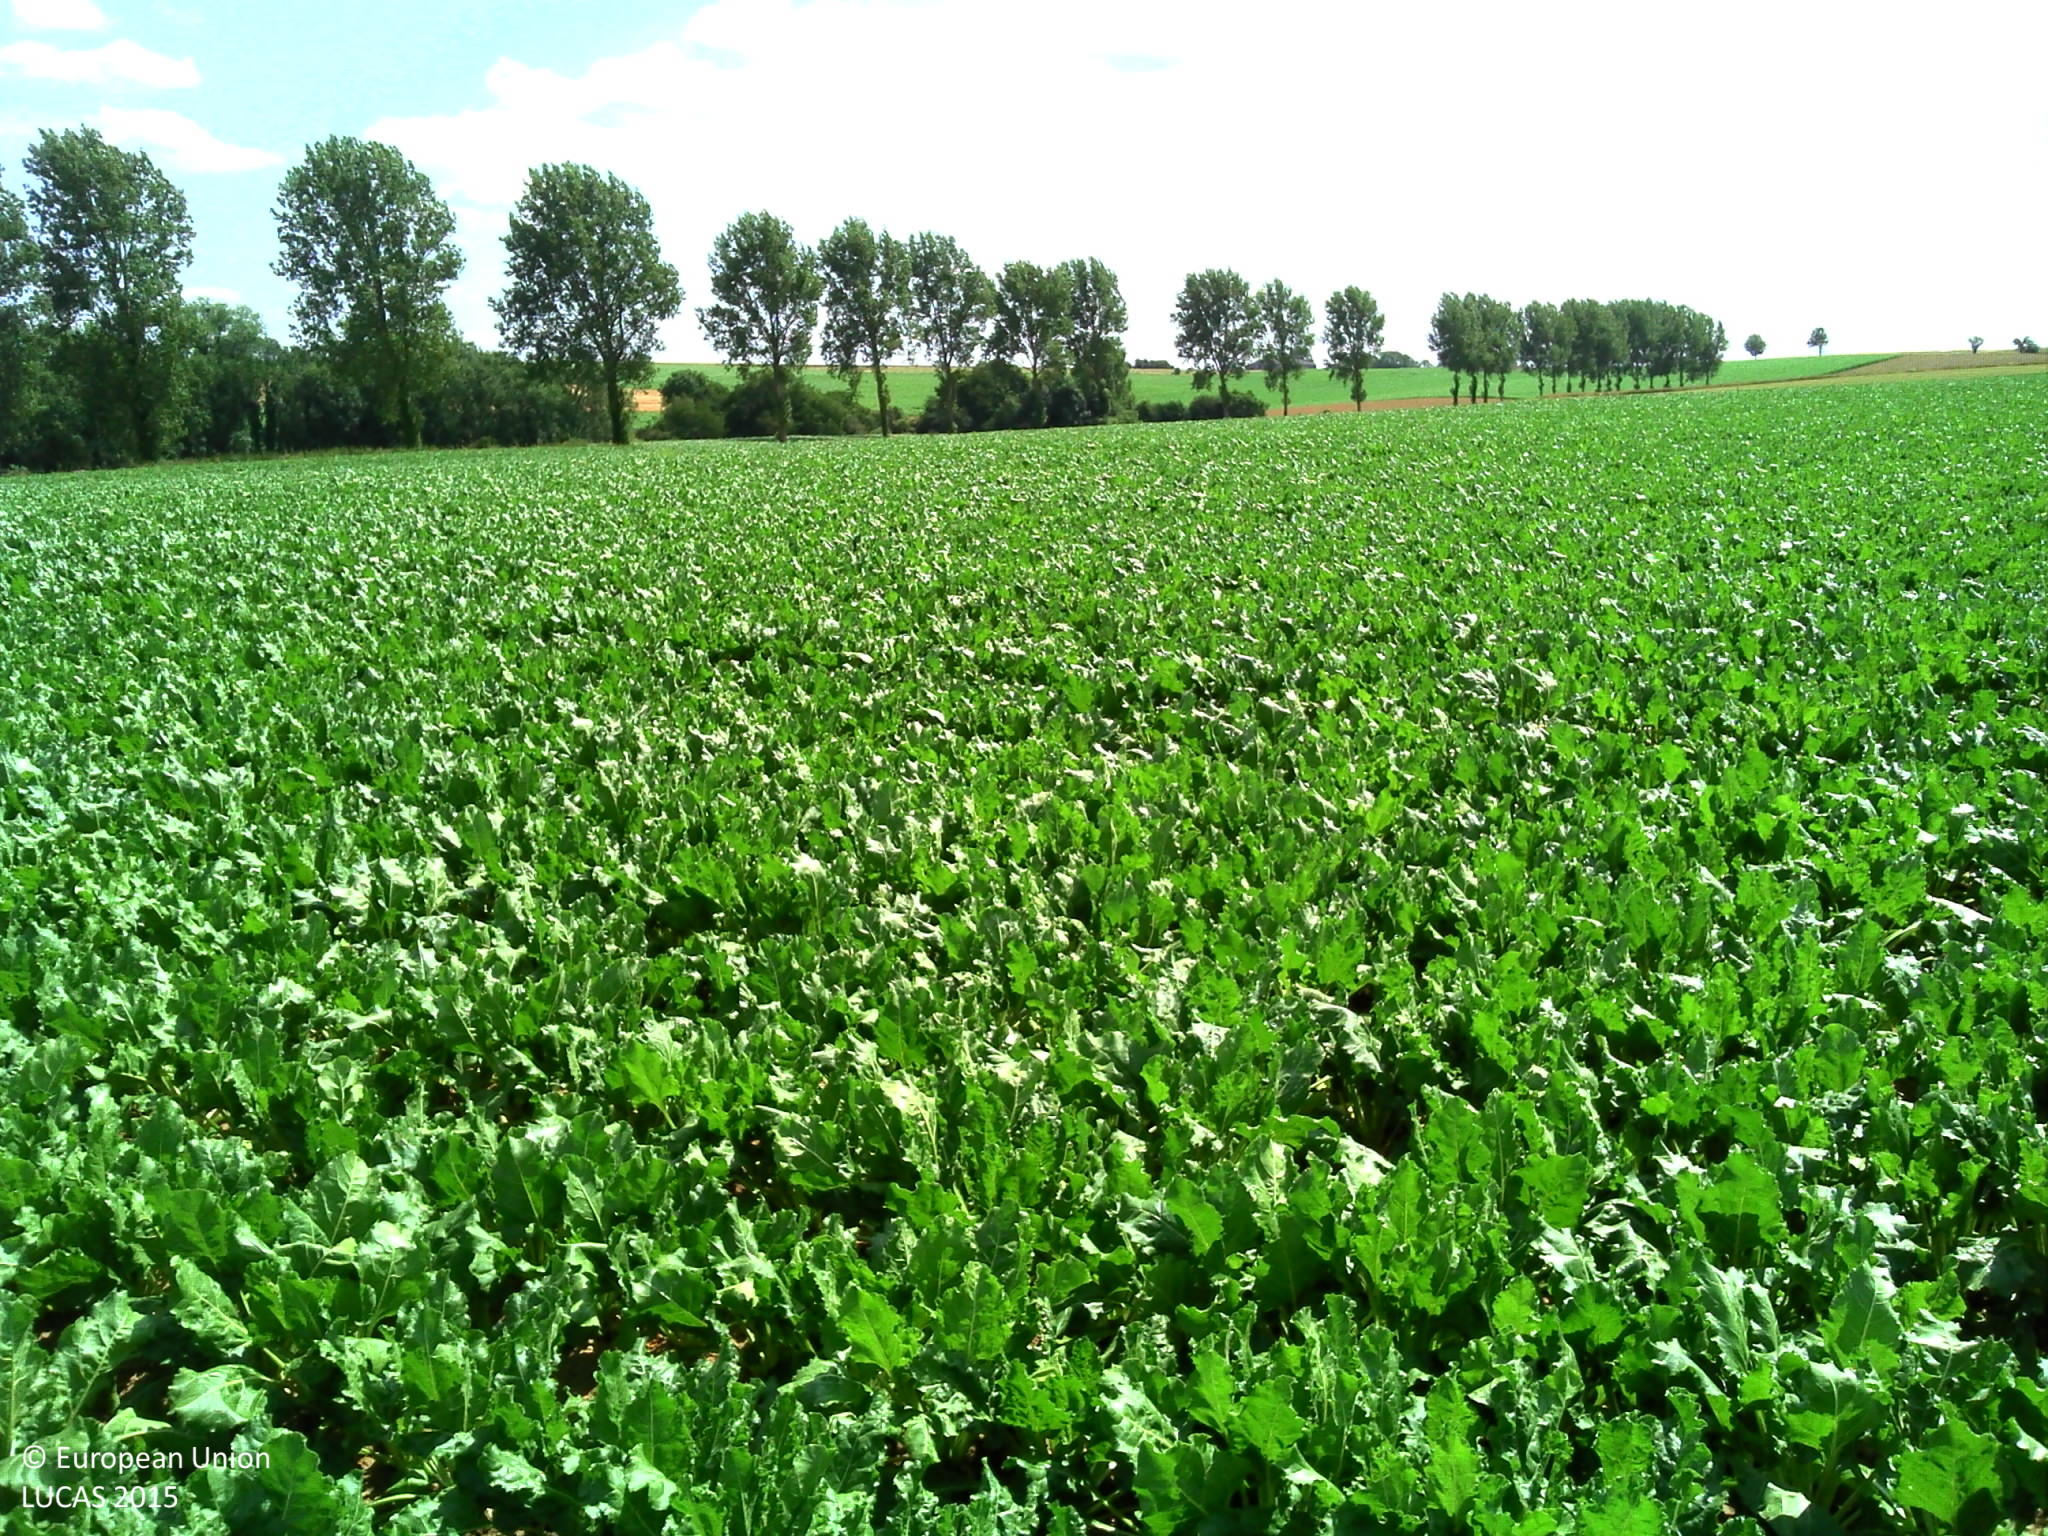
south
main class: Cropland
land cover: Sugar beet
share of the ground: > 75 %
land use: Agriculture (excluding fallow land and kitchen gardens)
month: July
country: FR
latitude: 50.2939
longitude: 2.1667
